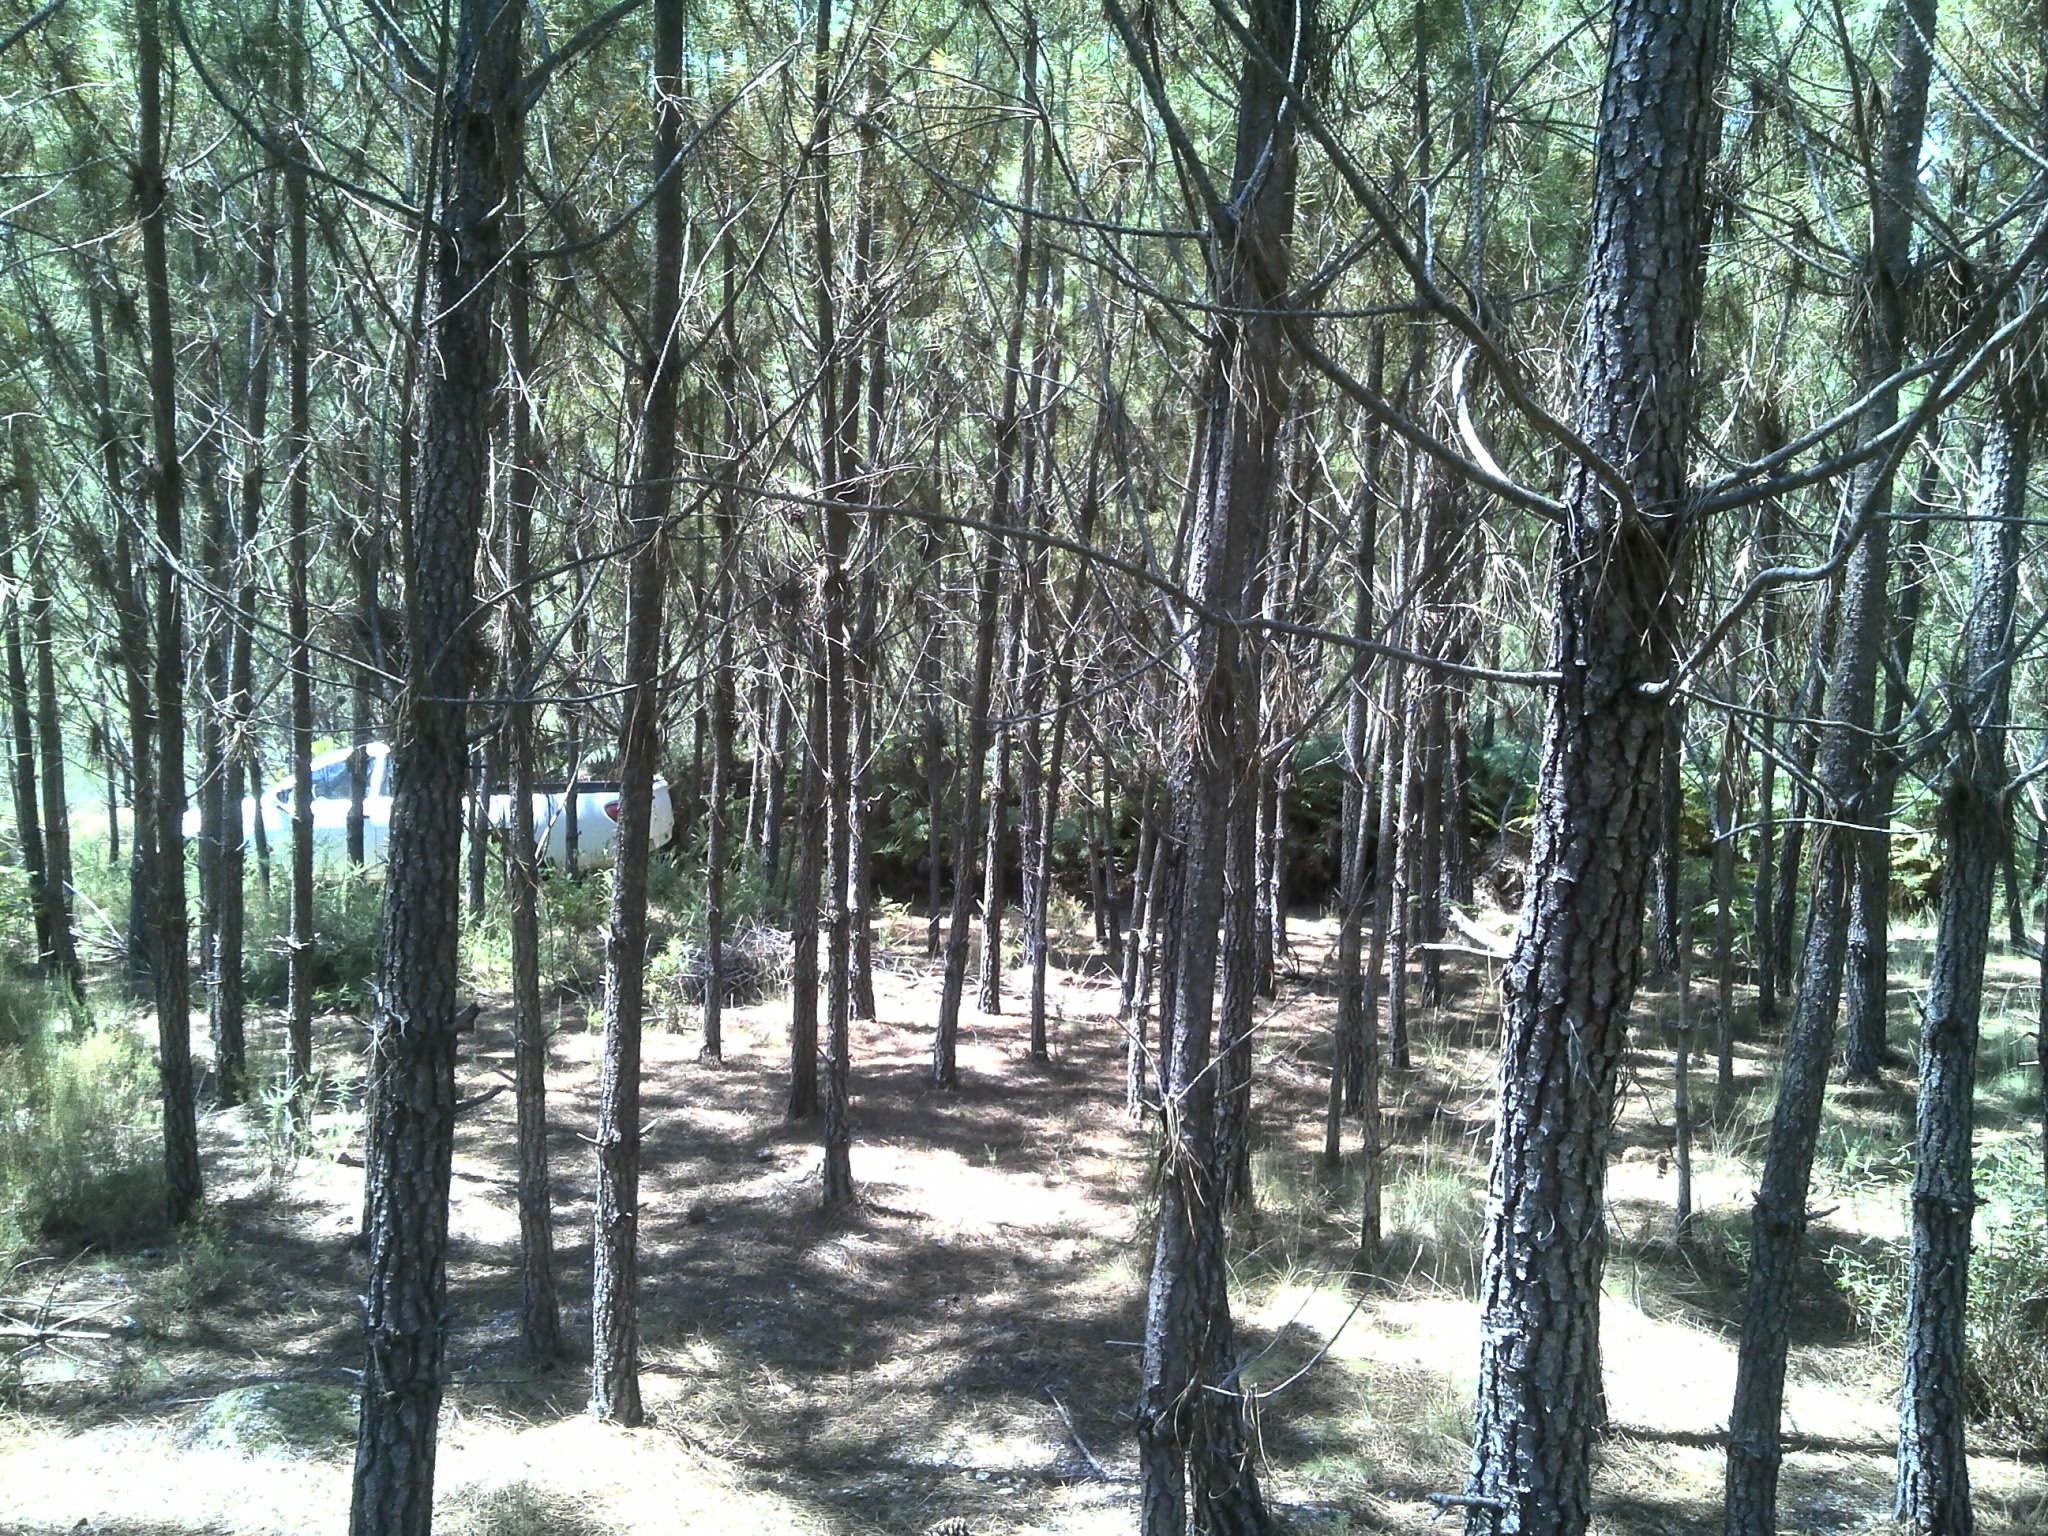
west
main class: Woodland
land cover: Pine dominated coniferous woodland
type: coniferous forest of the mediterranean region
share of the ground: 50 - 75 %
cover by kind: coniferous forest trees 75 %, unconsolidated bare surface 15 %, shrubs 10 %
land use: Forestry
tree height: > 5 m
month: June
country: PT
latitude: 40.5080
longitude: -8.0030
